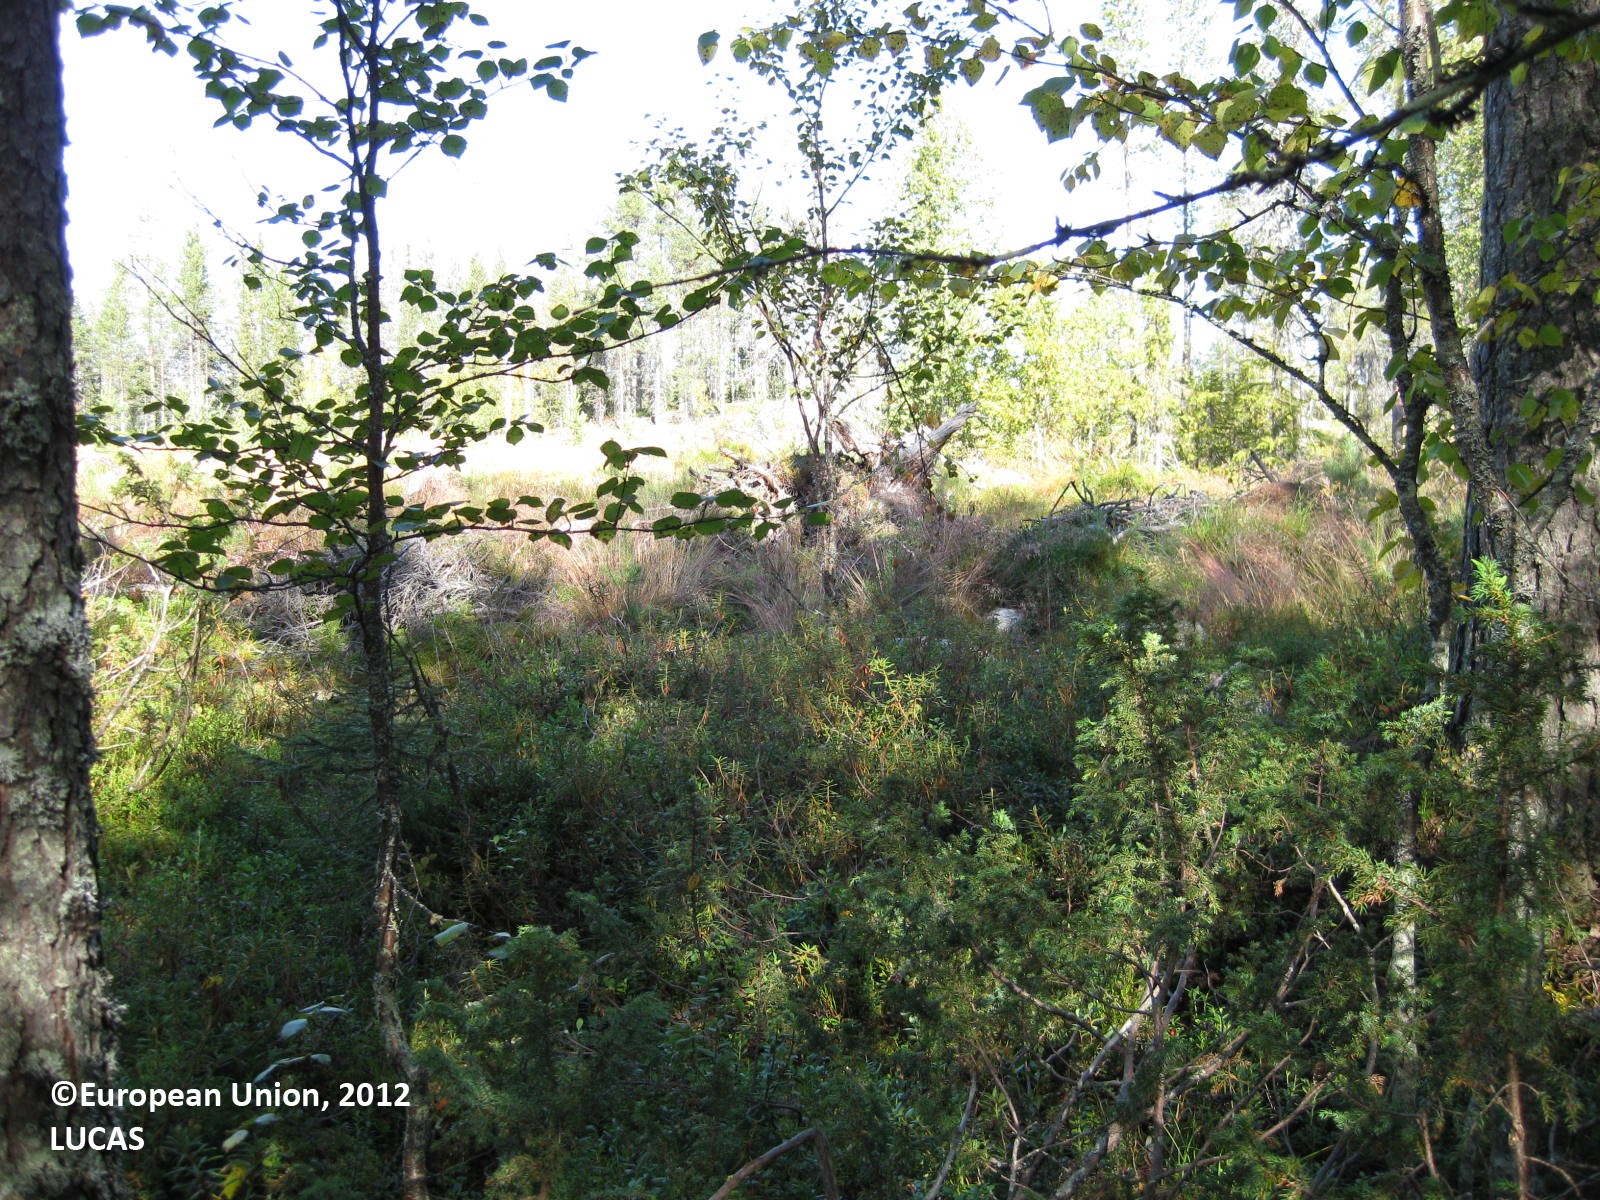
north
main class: Woodland
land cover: Other mixed woodland
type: boreal forest
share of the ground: > 75 %
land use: Forestry
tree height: > 5 m
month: August
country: FI
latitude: 65.9111
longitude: 28.6708
